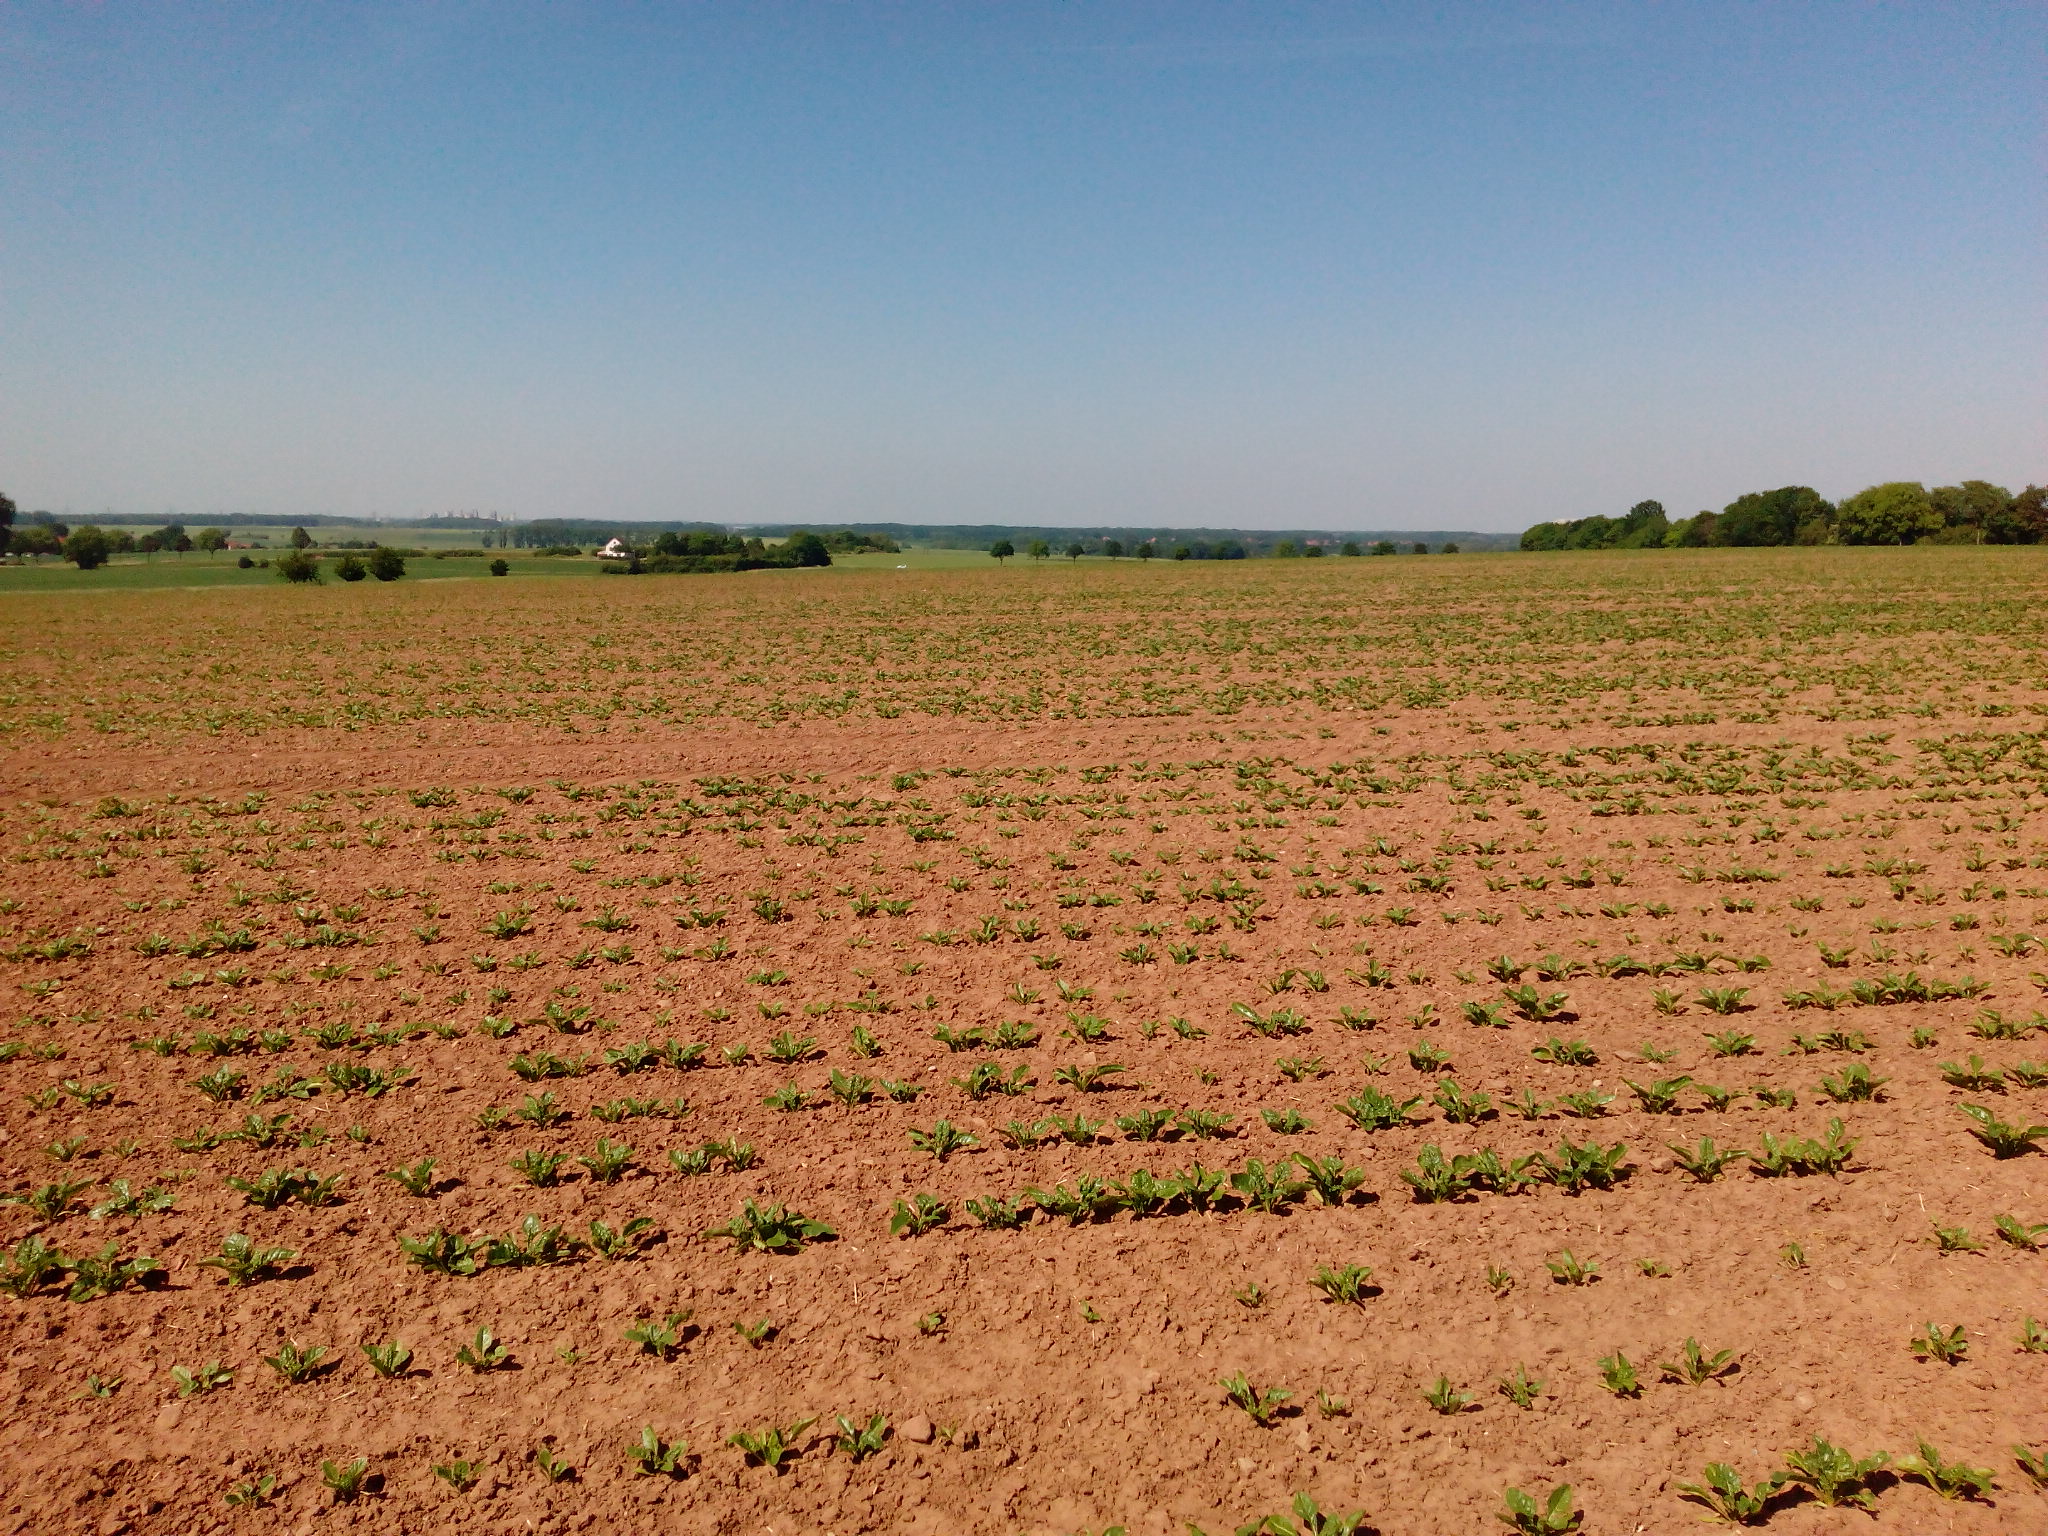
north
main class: Cropland
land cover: Rape and turnip rape
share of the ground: > 75 %
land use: Agriculture (excluding fallow land and kitchen gardens)
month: June
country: DE
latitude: 52.2876
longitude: 9.9267
